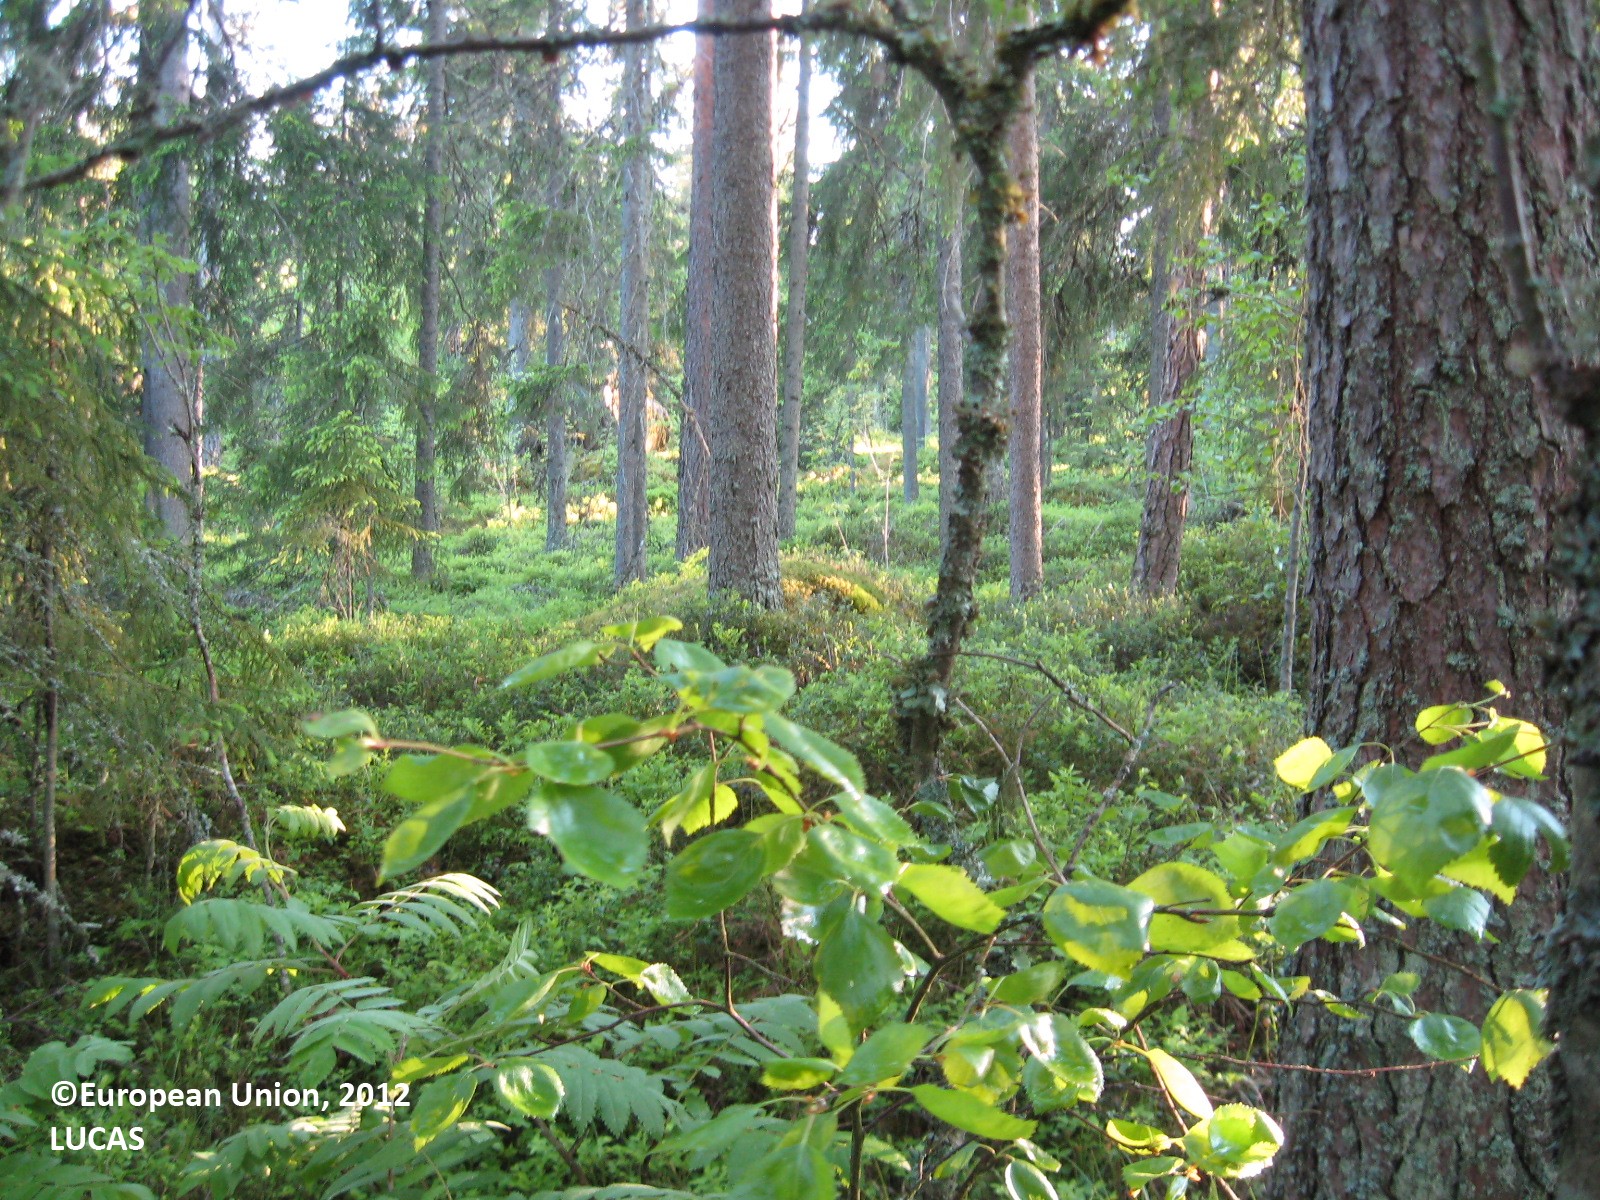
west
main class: Woodland
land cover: Spruce dominated coniferous woodland
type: boreal forest
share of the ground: > 75 %
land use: Forestry
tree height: > 5 m
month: June
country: FI
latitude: 63.1351
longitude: 22.6881
